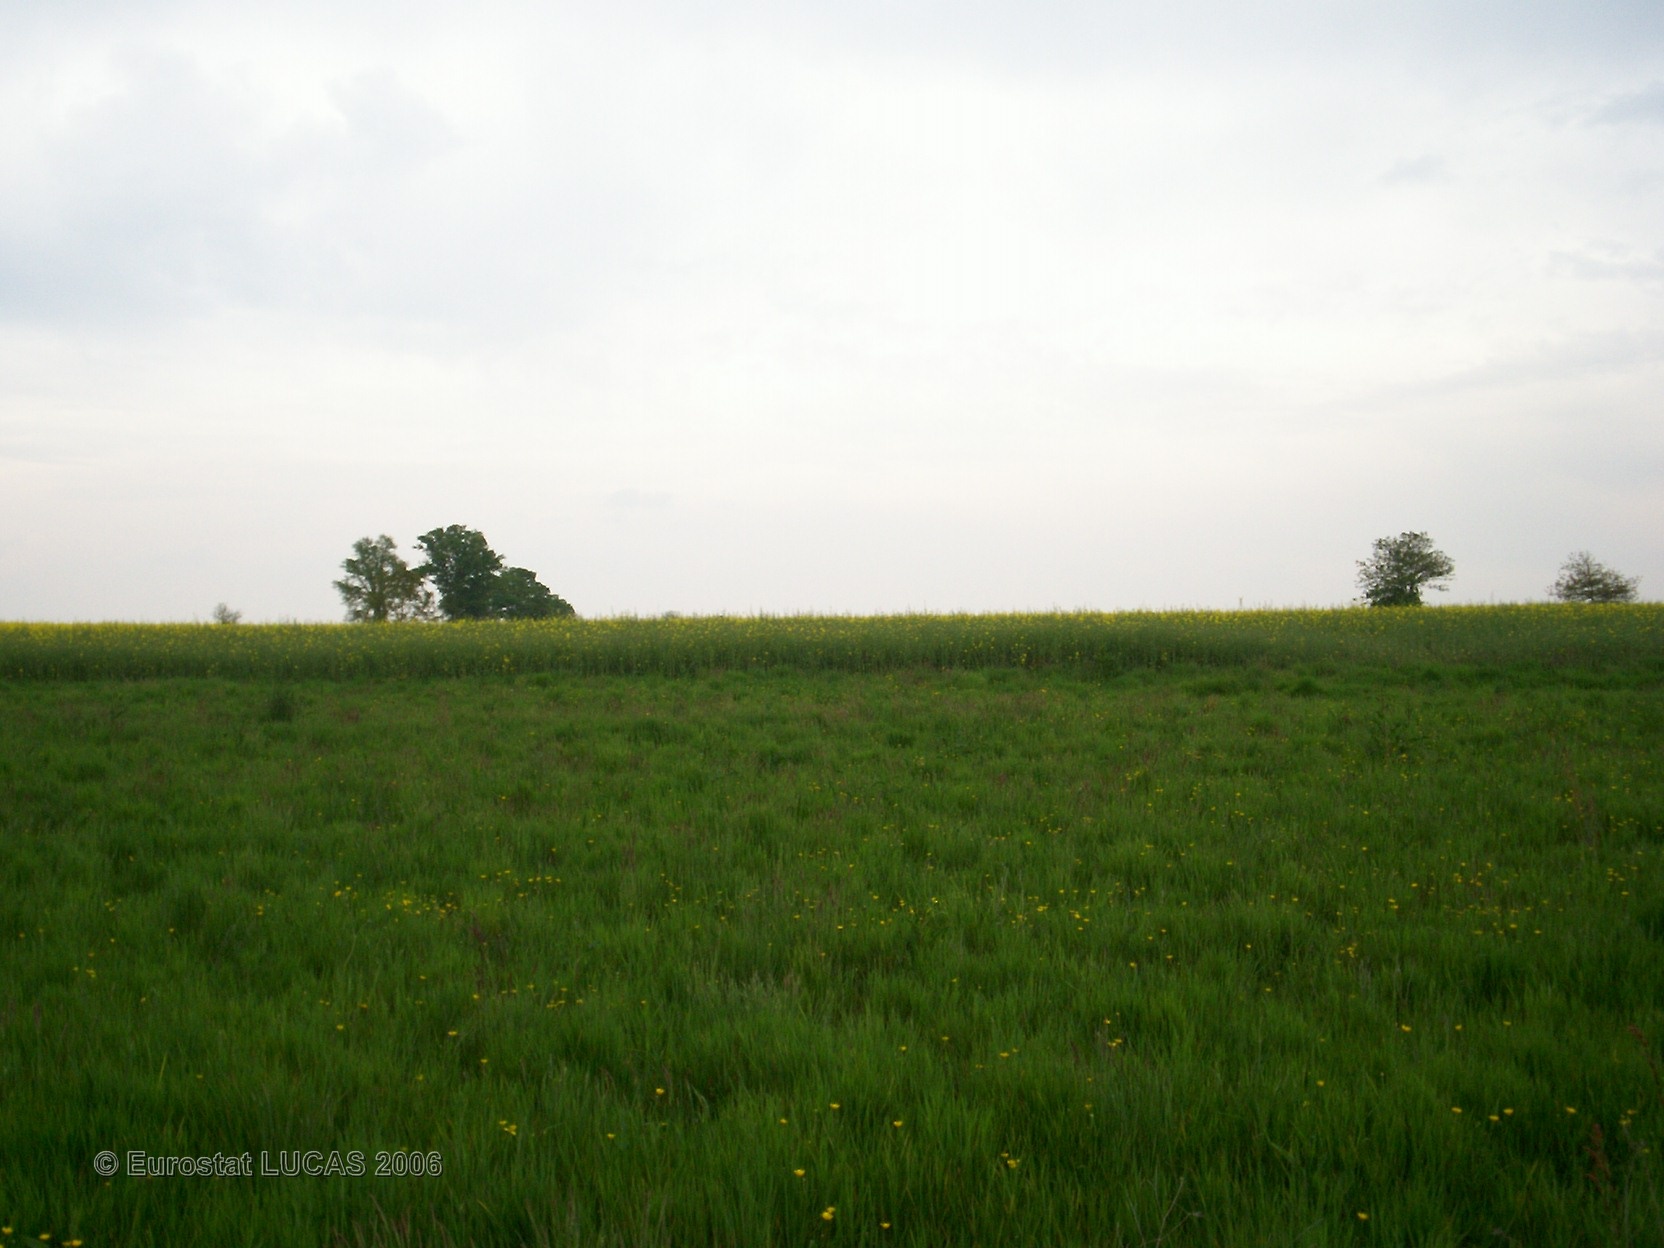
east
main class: Grassland
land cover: Grassland without tree/shrub cover
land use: Agriculture (excluding fallow land and kitchen gardens)
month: May
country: FR
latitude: 47.8107
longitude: -2.2469
